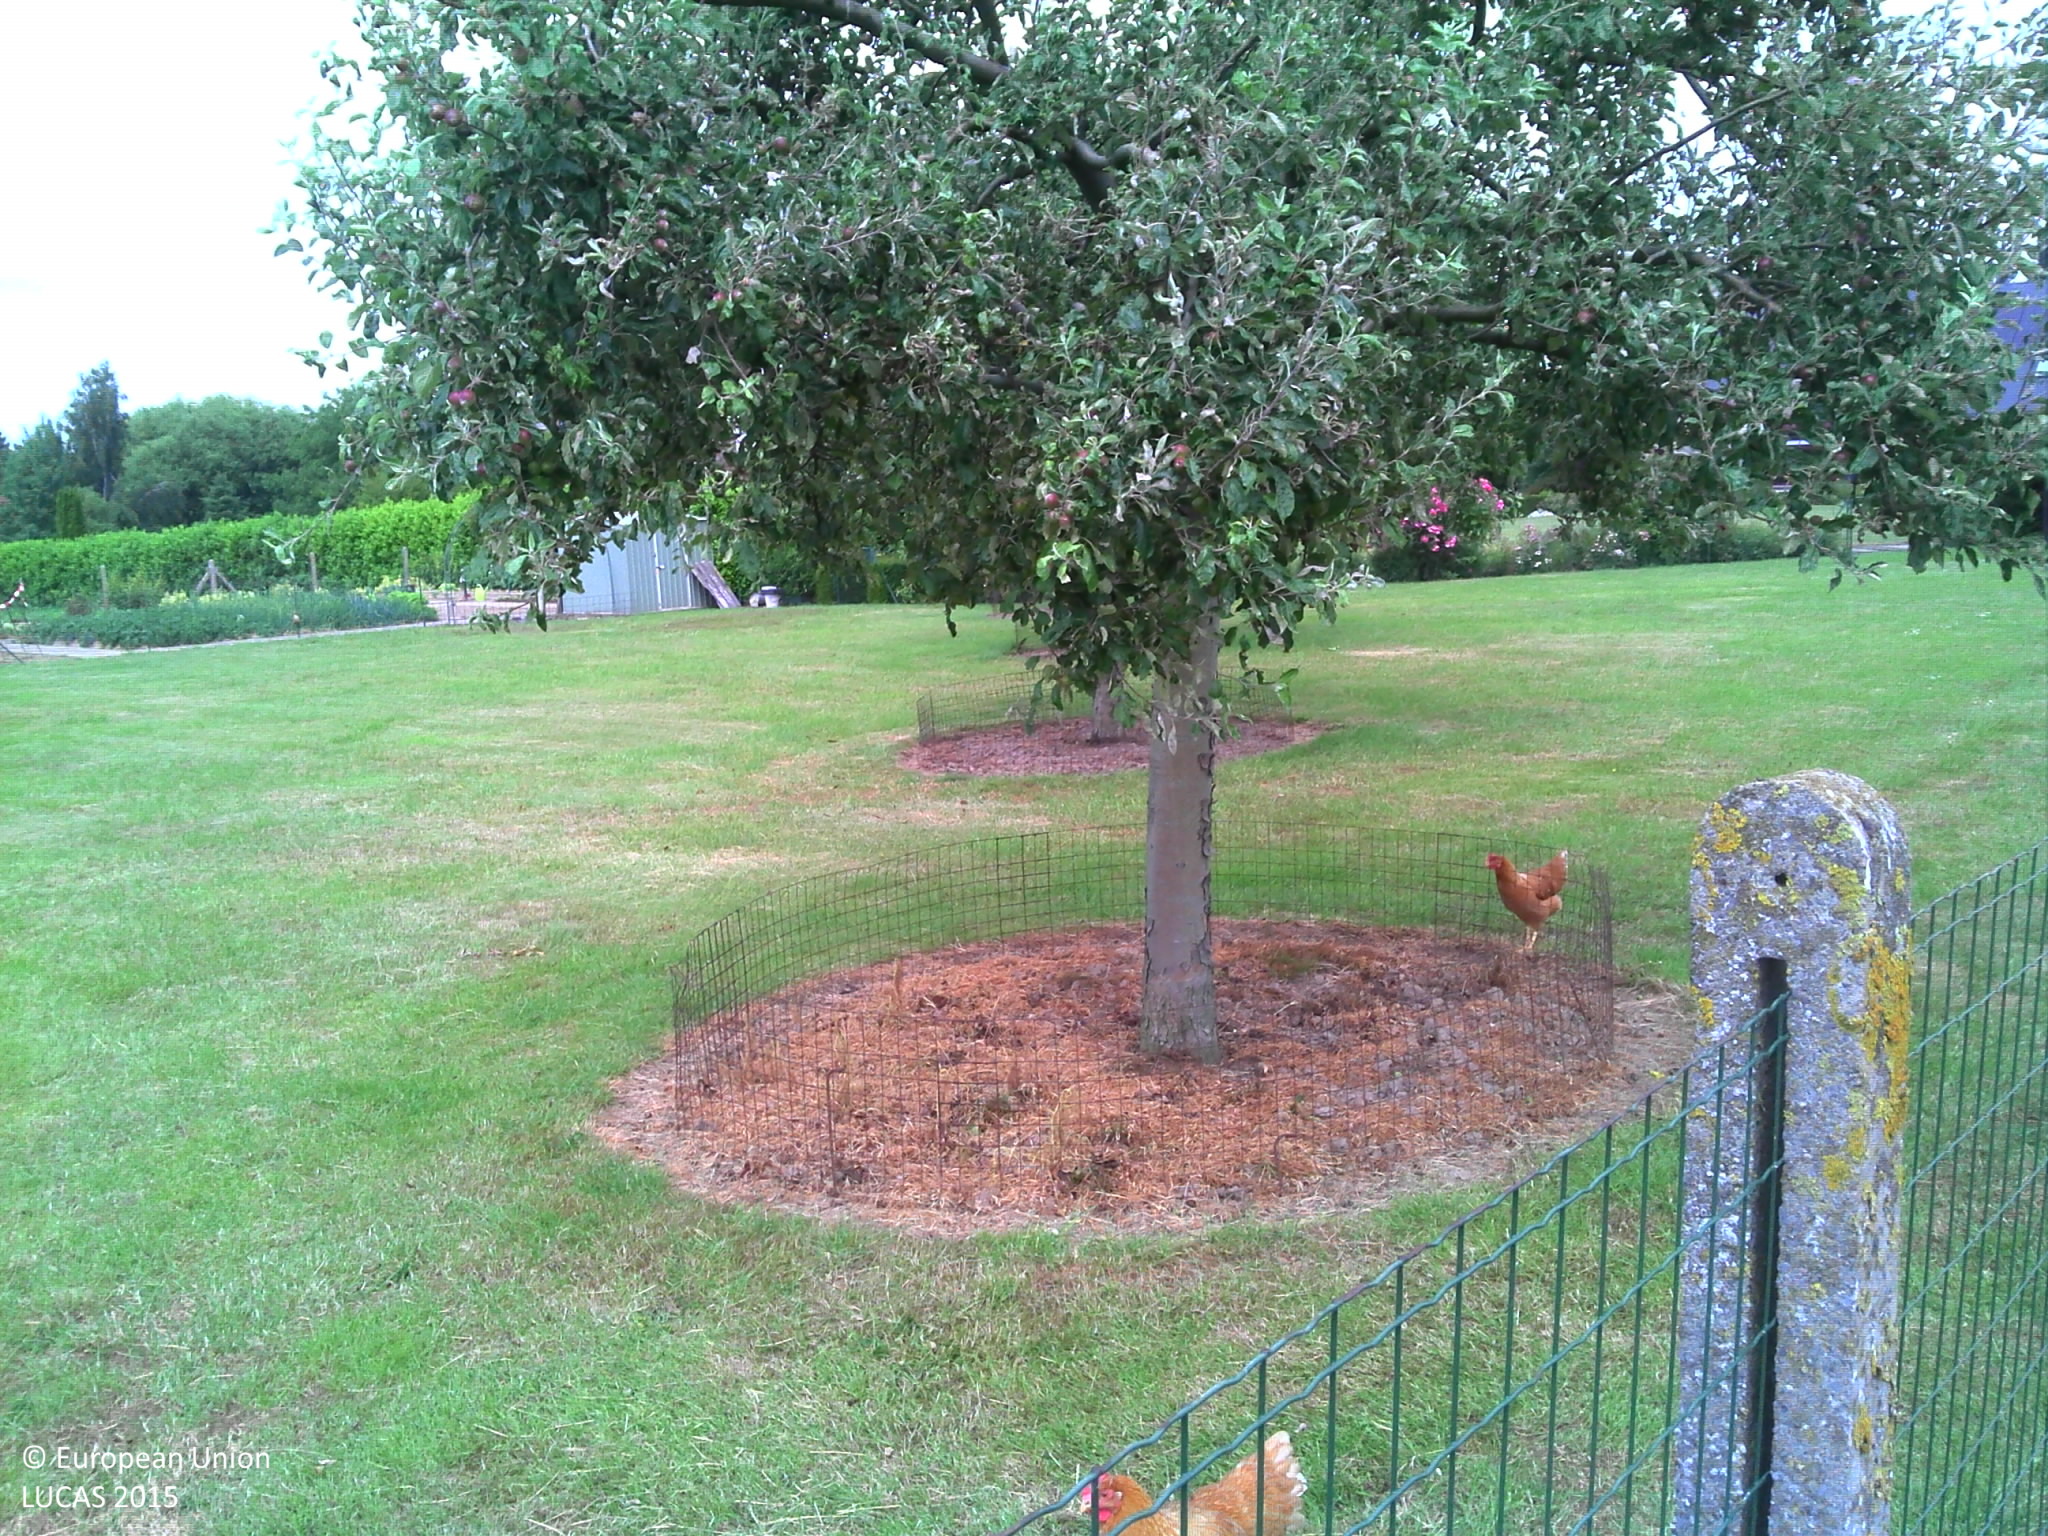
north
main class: Grassland
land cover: Grassland with sparse tree/shrub cover
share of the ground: > 75 %
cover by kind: herbaceous plants 95 %, broadleaved forest trees 5 %
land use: Residential
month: June
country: BE
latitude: 50.3876
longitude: 3.6779
